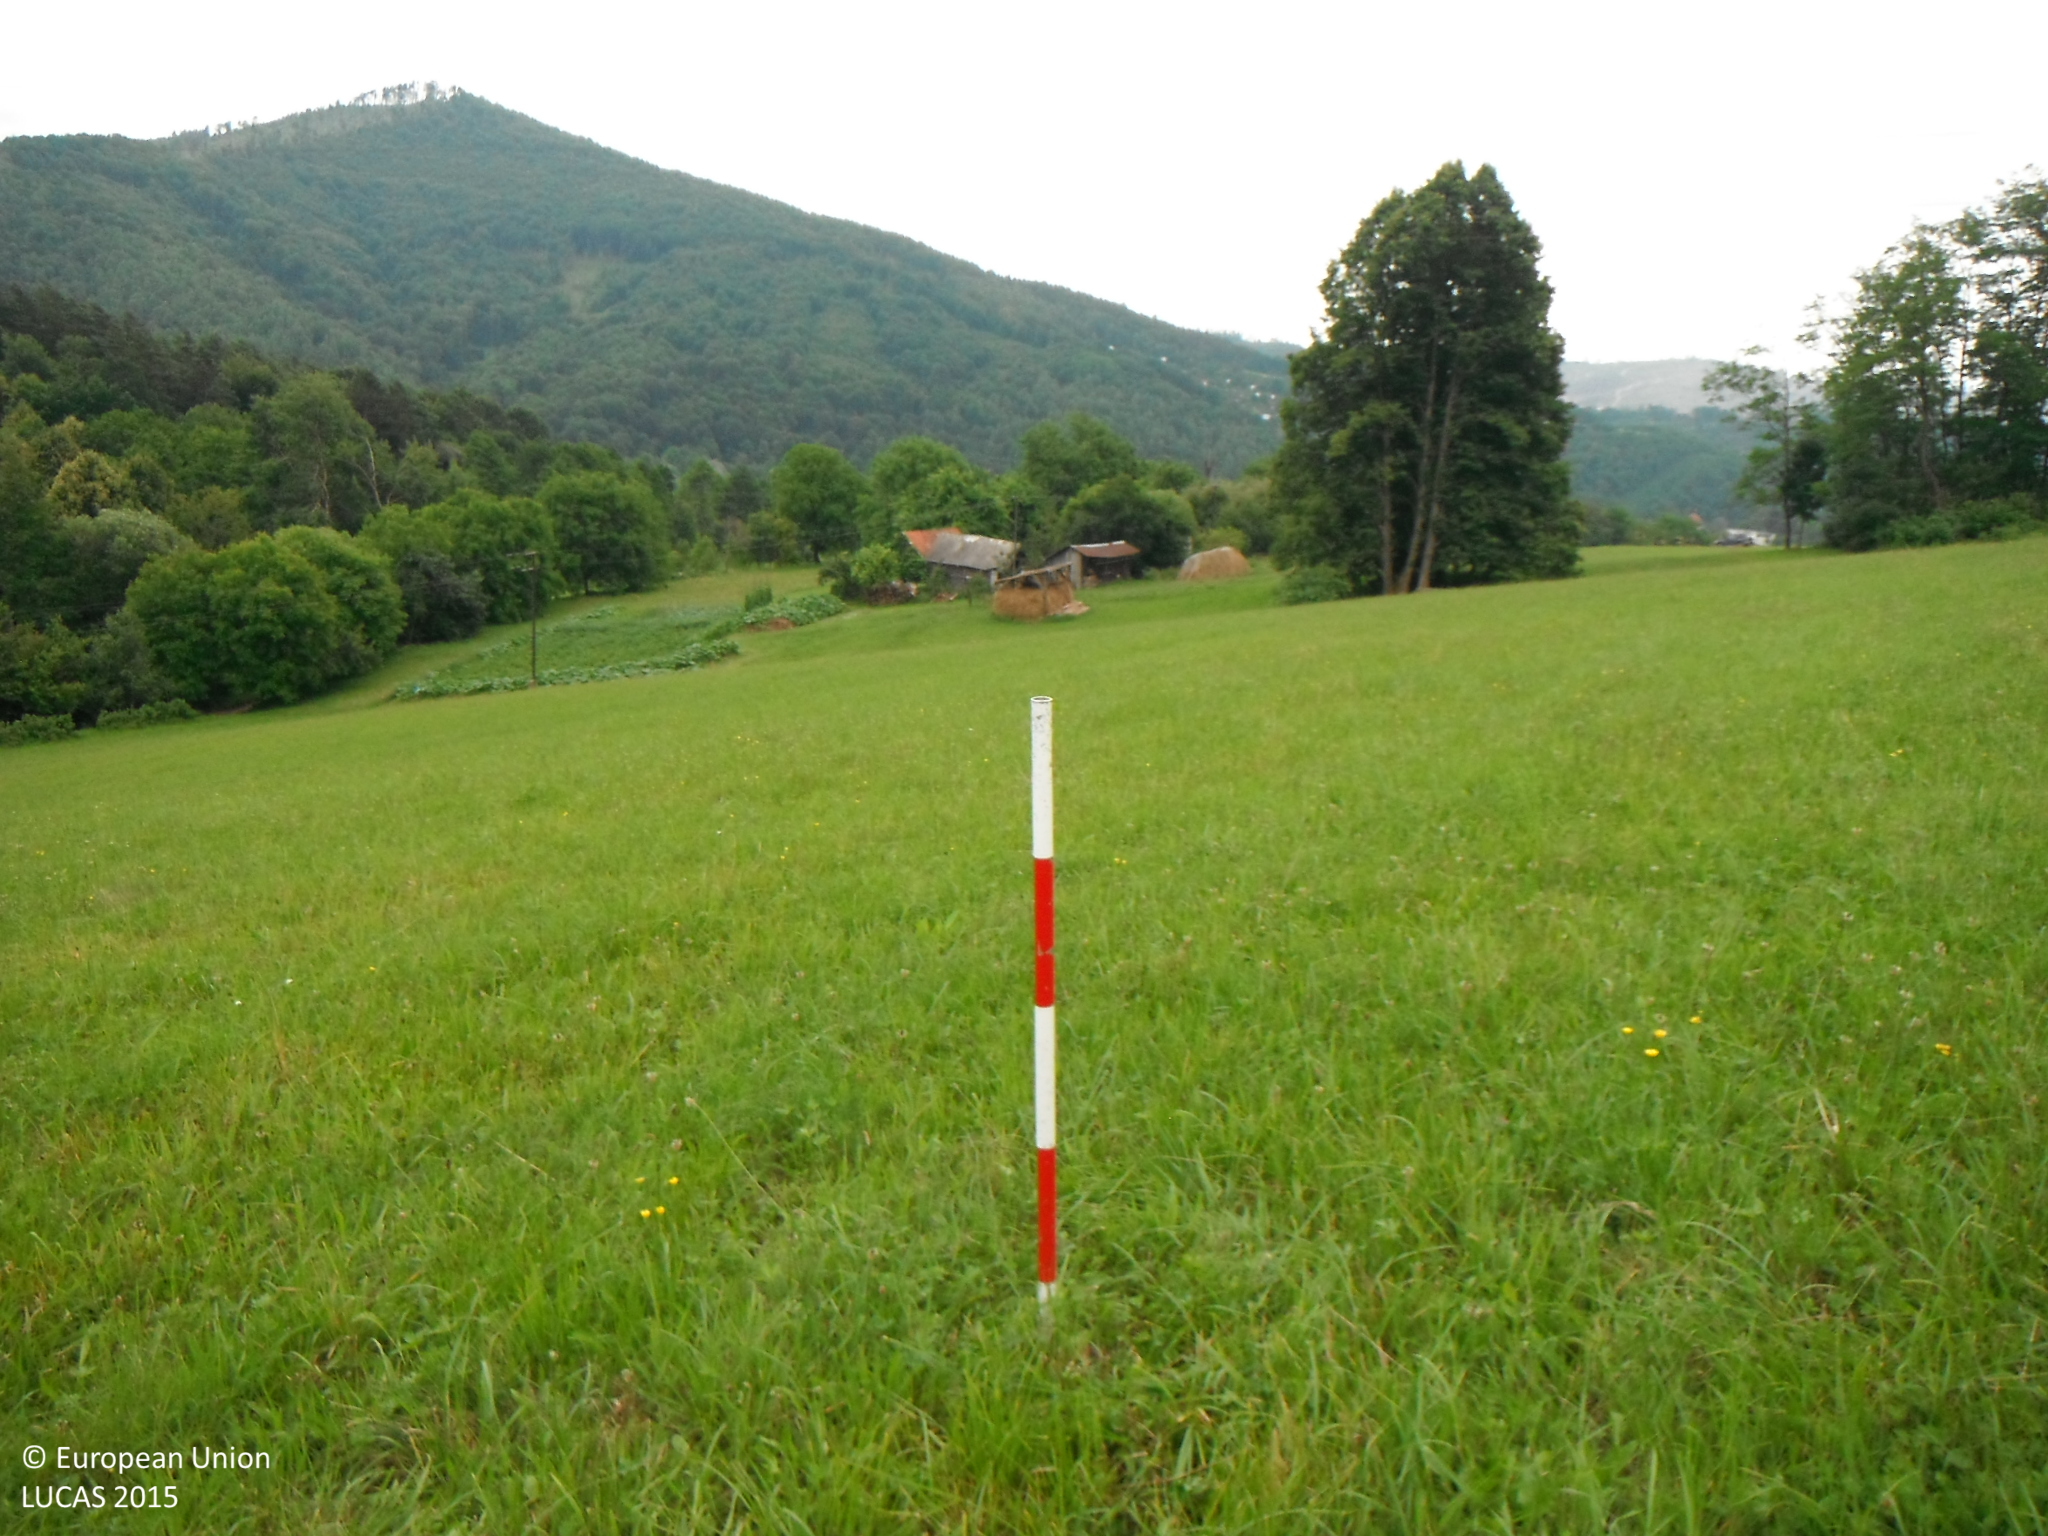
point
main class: Grassland
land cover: Grassland without tree/shrub cover
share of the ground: > 75 %
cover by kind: herbaceous plants 100 %
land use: Agriculture (excluding fallow land and kitchen gardens)
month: June
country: SK
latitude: 48.5890
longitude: 19.9397
